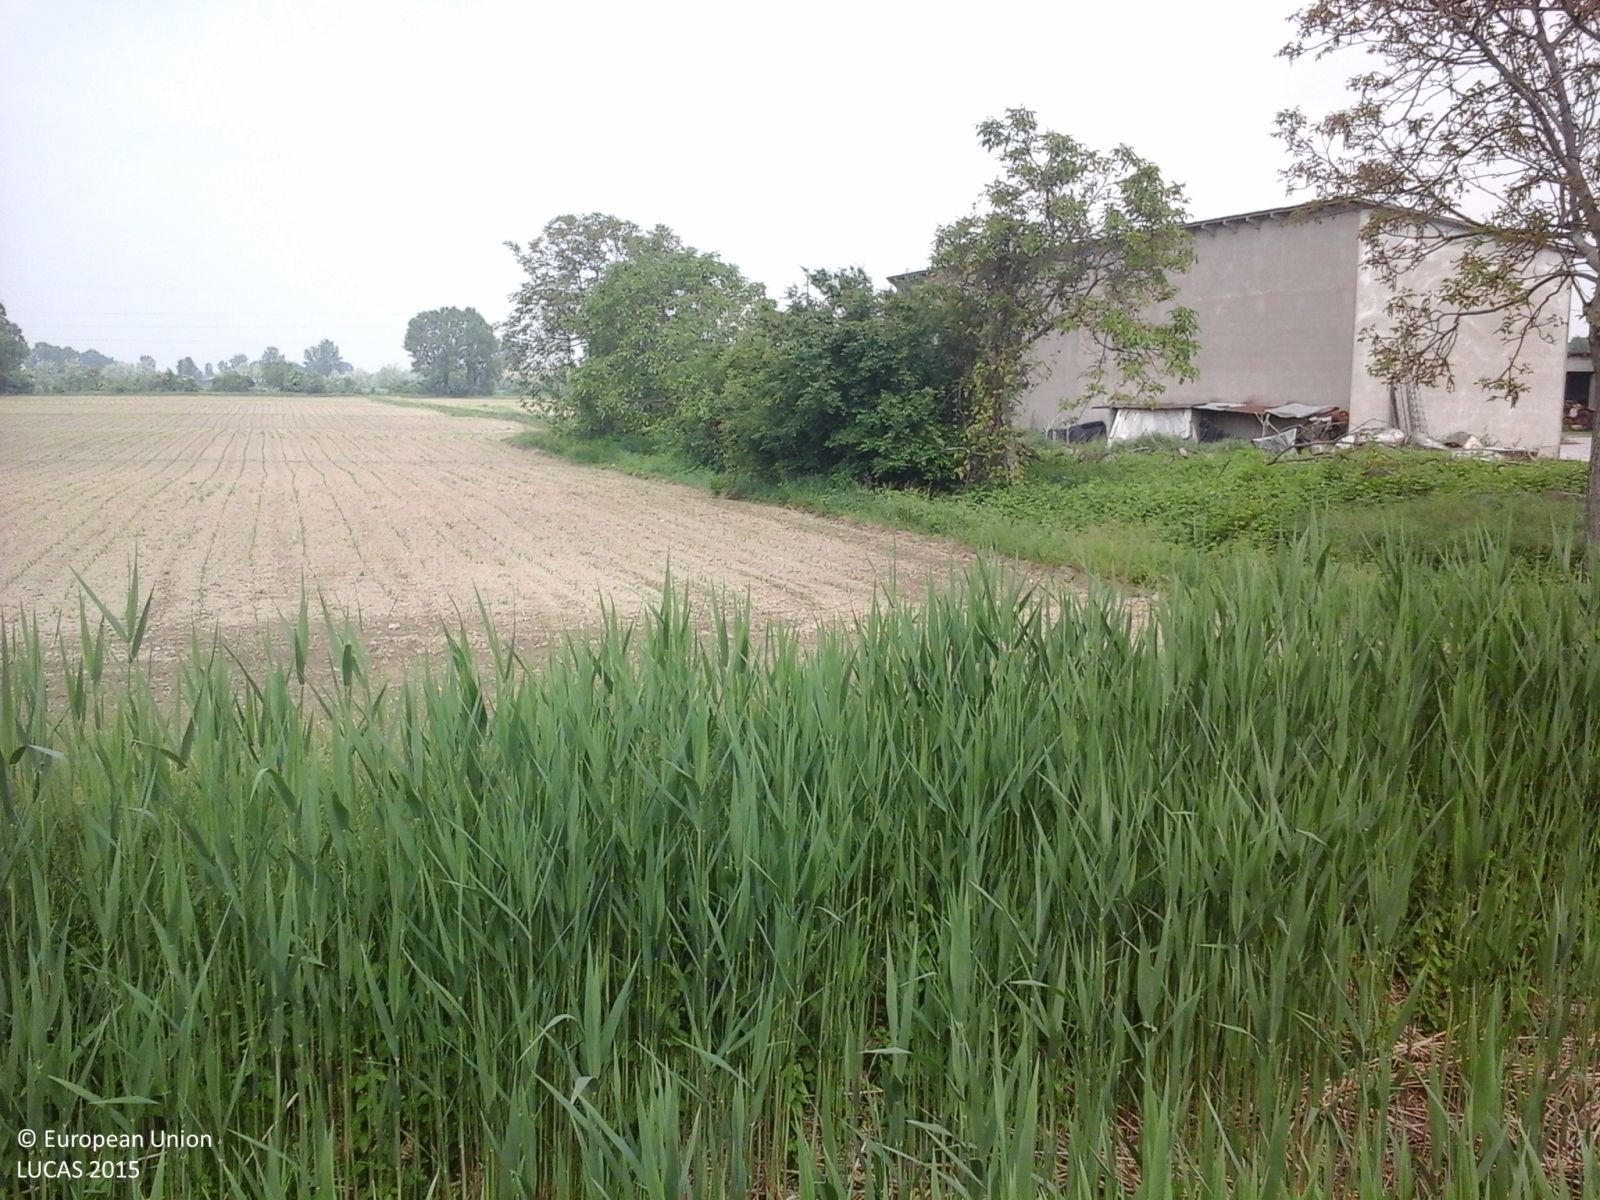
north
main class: Cropland
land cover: Maize
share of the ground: < 10 %
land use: Agriculture (excluding fallow land and kitchen gardens)
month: May
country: IT
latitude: 45.1796
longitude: 10.2667
